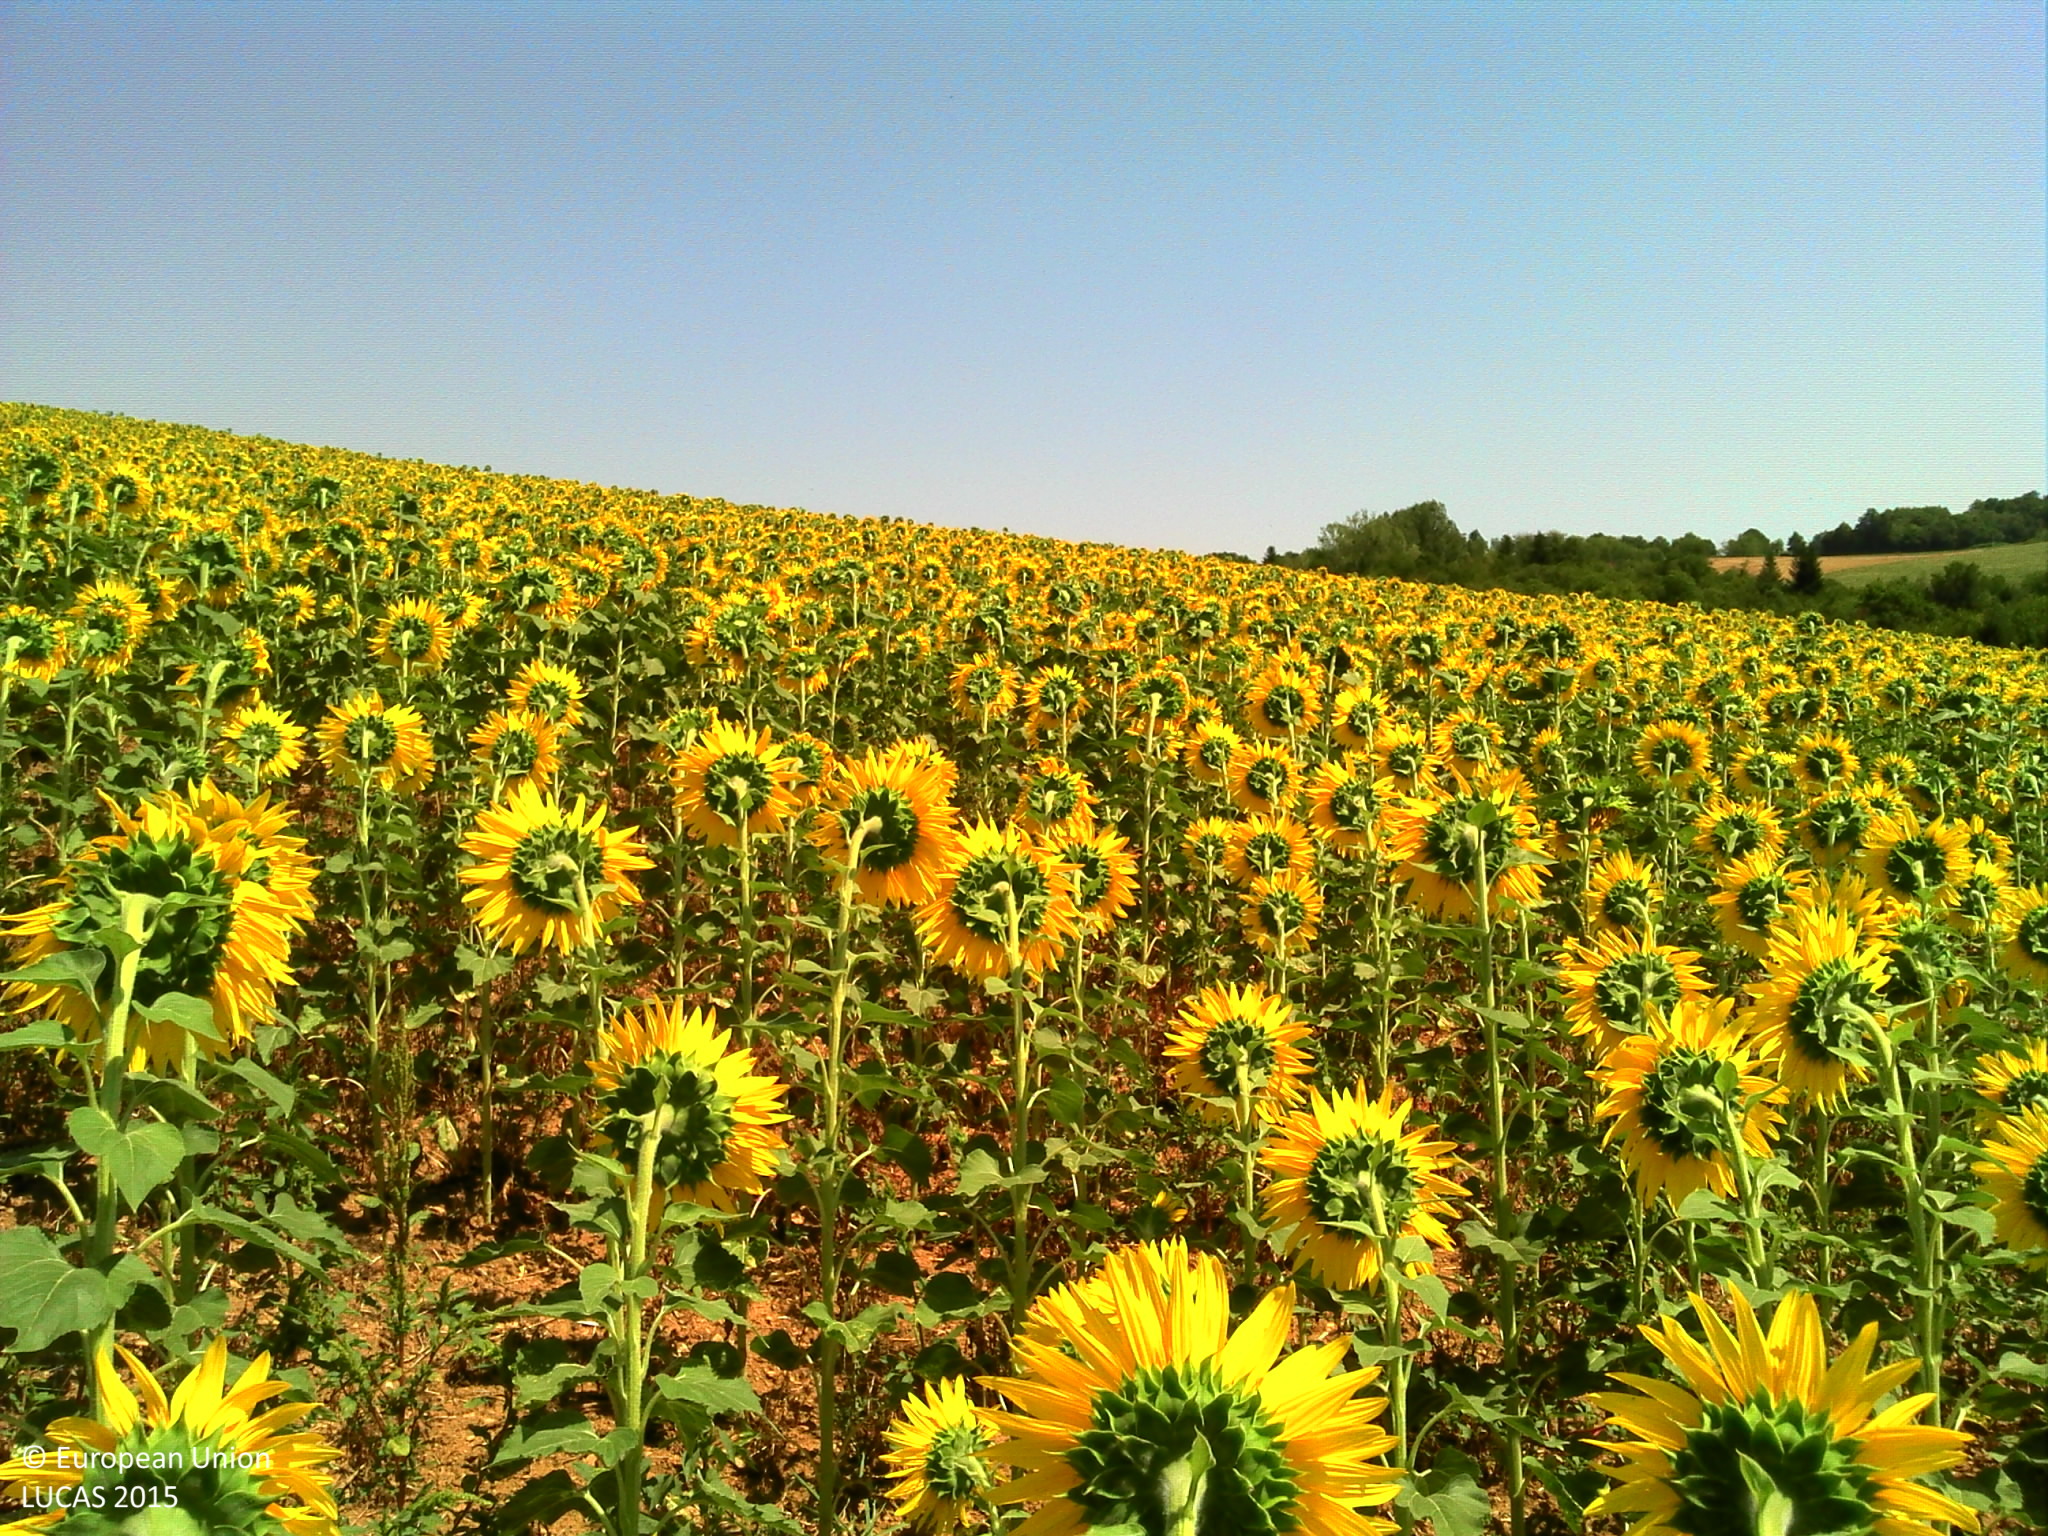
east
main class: Cropland
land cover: Sunflower
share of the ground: 50 - 75 %
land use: Agriculture (excluding fallow land and kitchen gardens)
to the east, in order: Sunflower; Electric lines; Sunflower; Grass margins; Tracks; Grass margins; Spruce dominated coniferous woodland
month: August
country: FR
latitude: 45.3630
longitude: 1.0934
